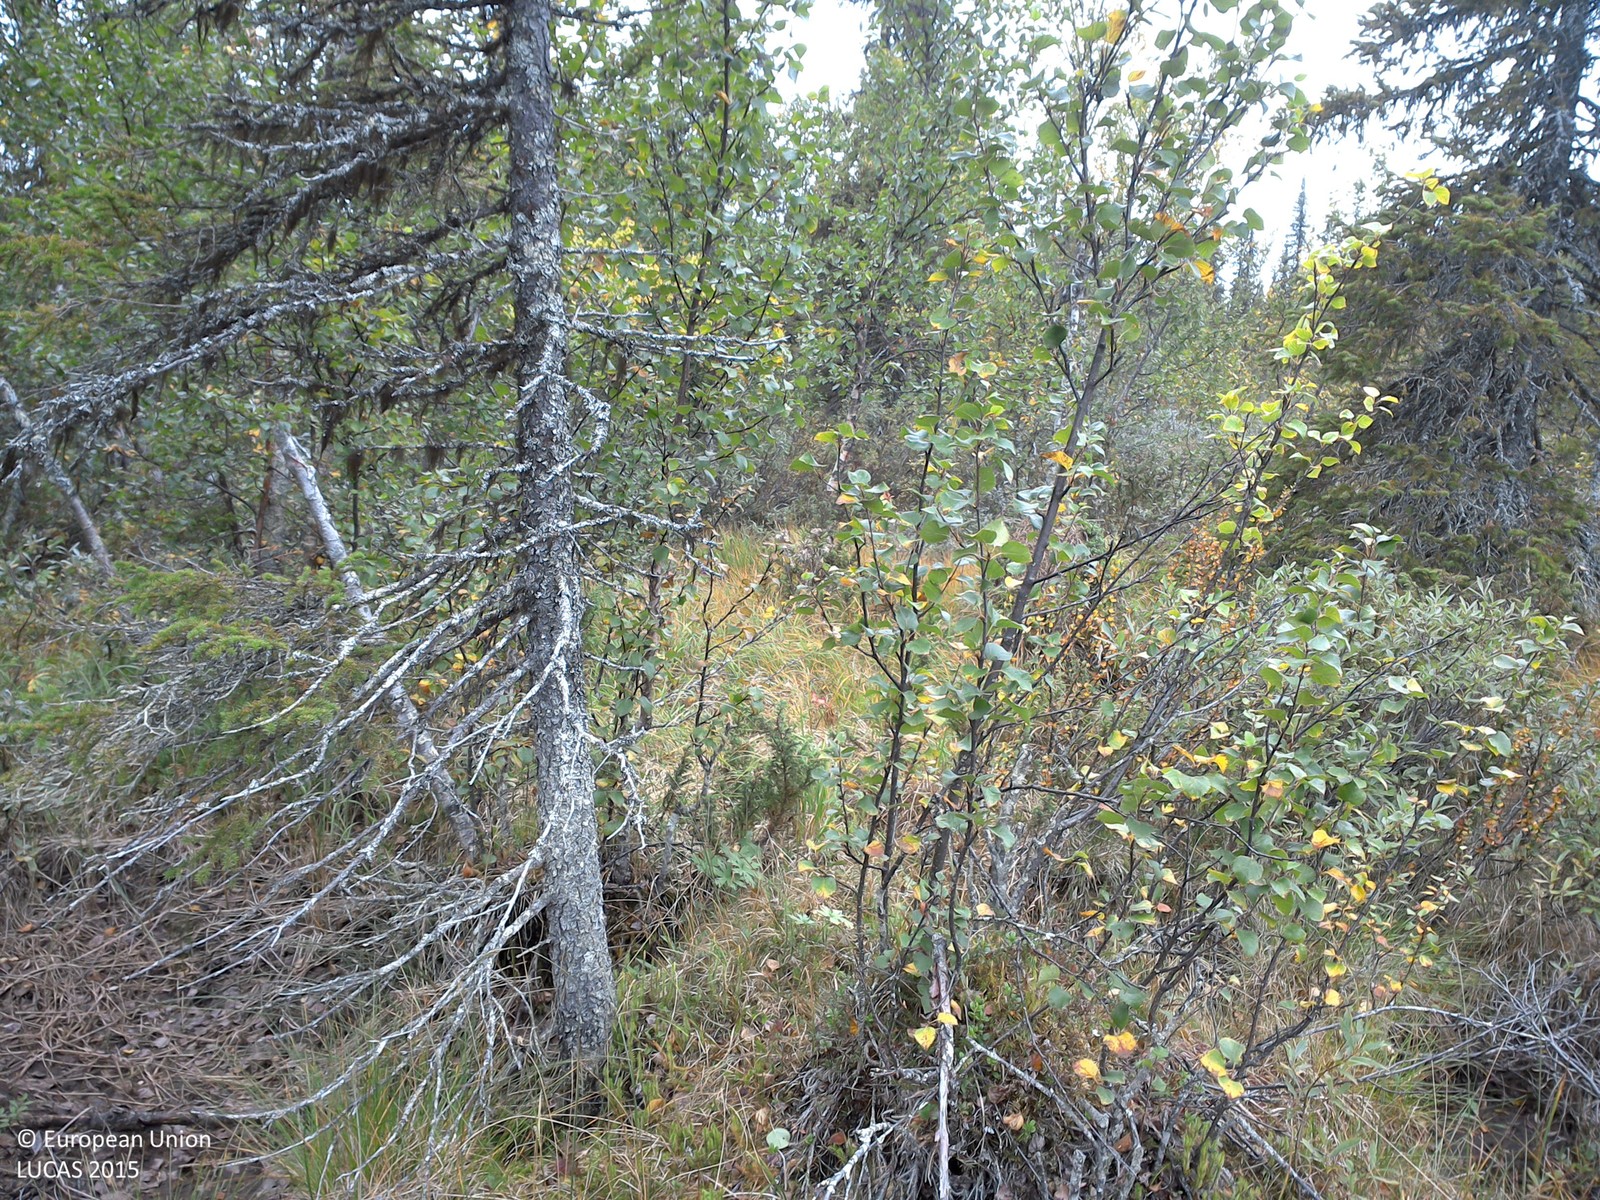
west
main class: Woodland
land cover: Spruce dominated mixed woodland
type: boreal forest
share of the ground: 25 - 50 %
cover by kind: shrubs 45 %, coniferous forest trees 20 %, herbaceous plants 20 %, broadleaved forest trees 10 %, lichens and mosses 5 %
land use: Amenities, museums, leisure
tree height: > 5 m
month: August
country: SE
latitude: 67.8769
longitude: 21.5805
